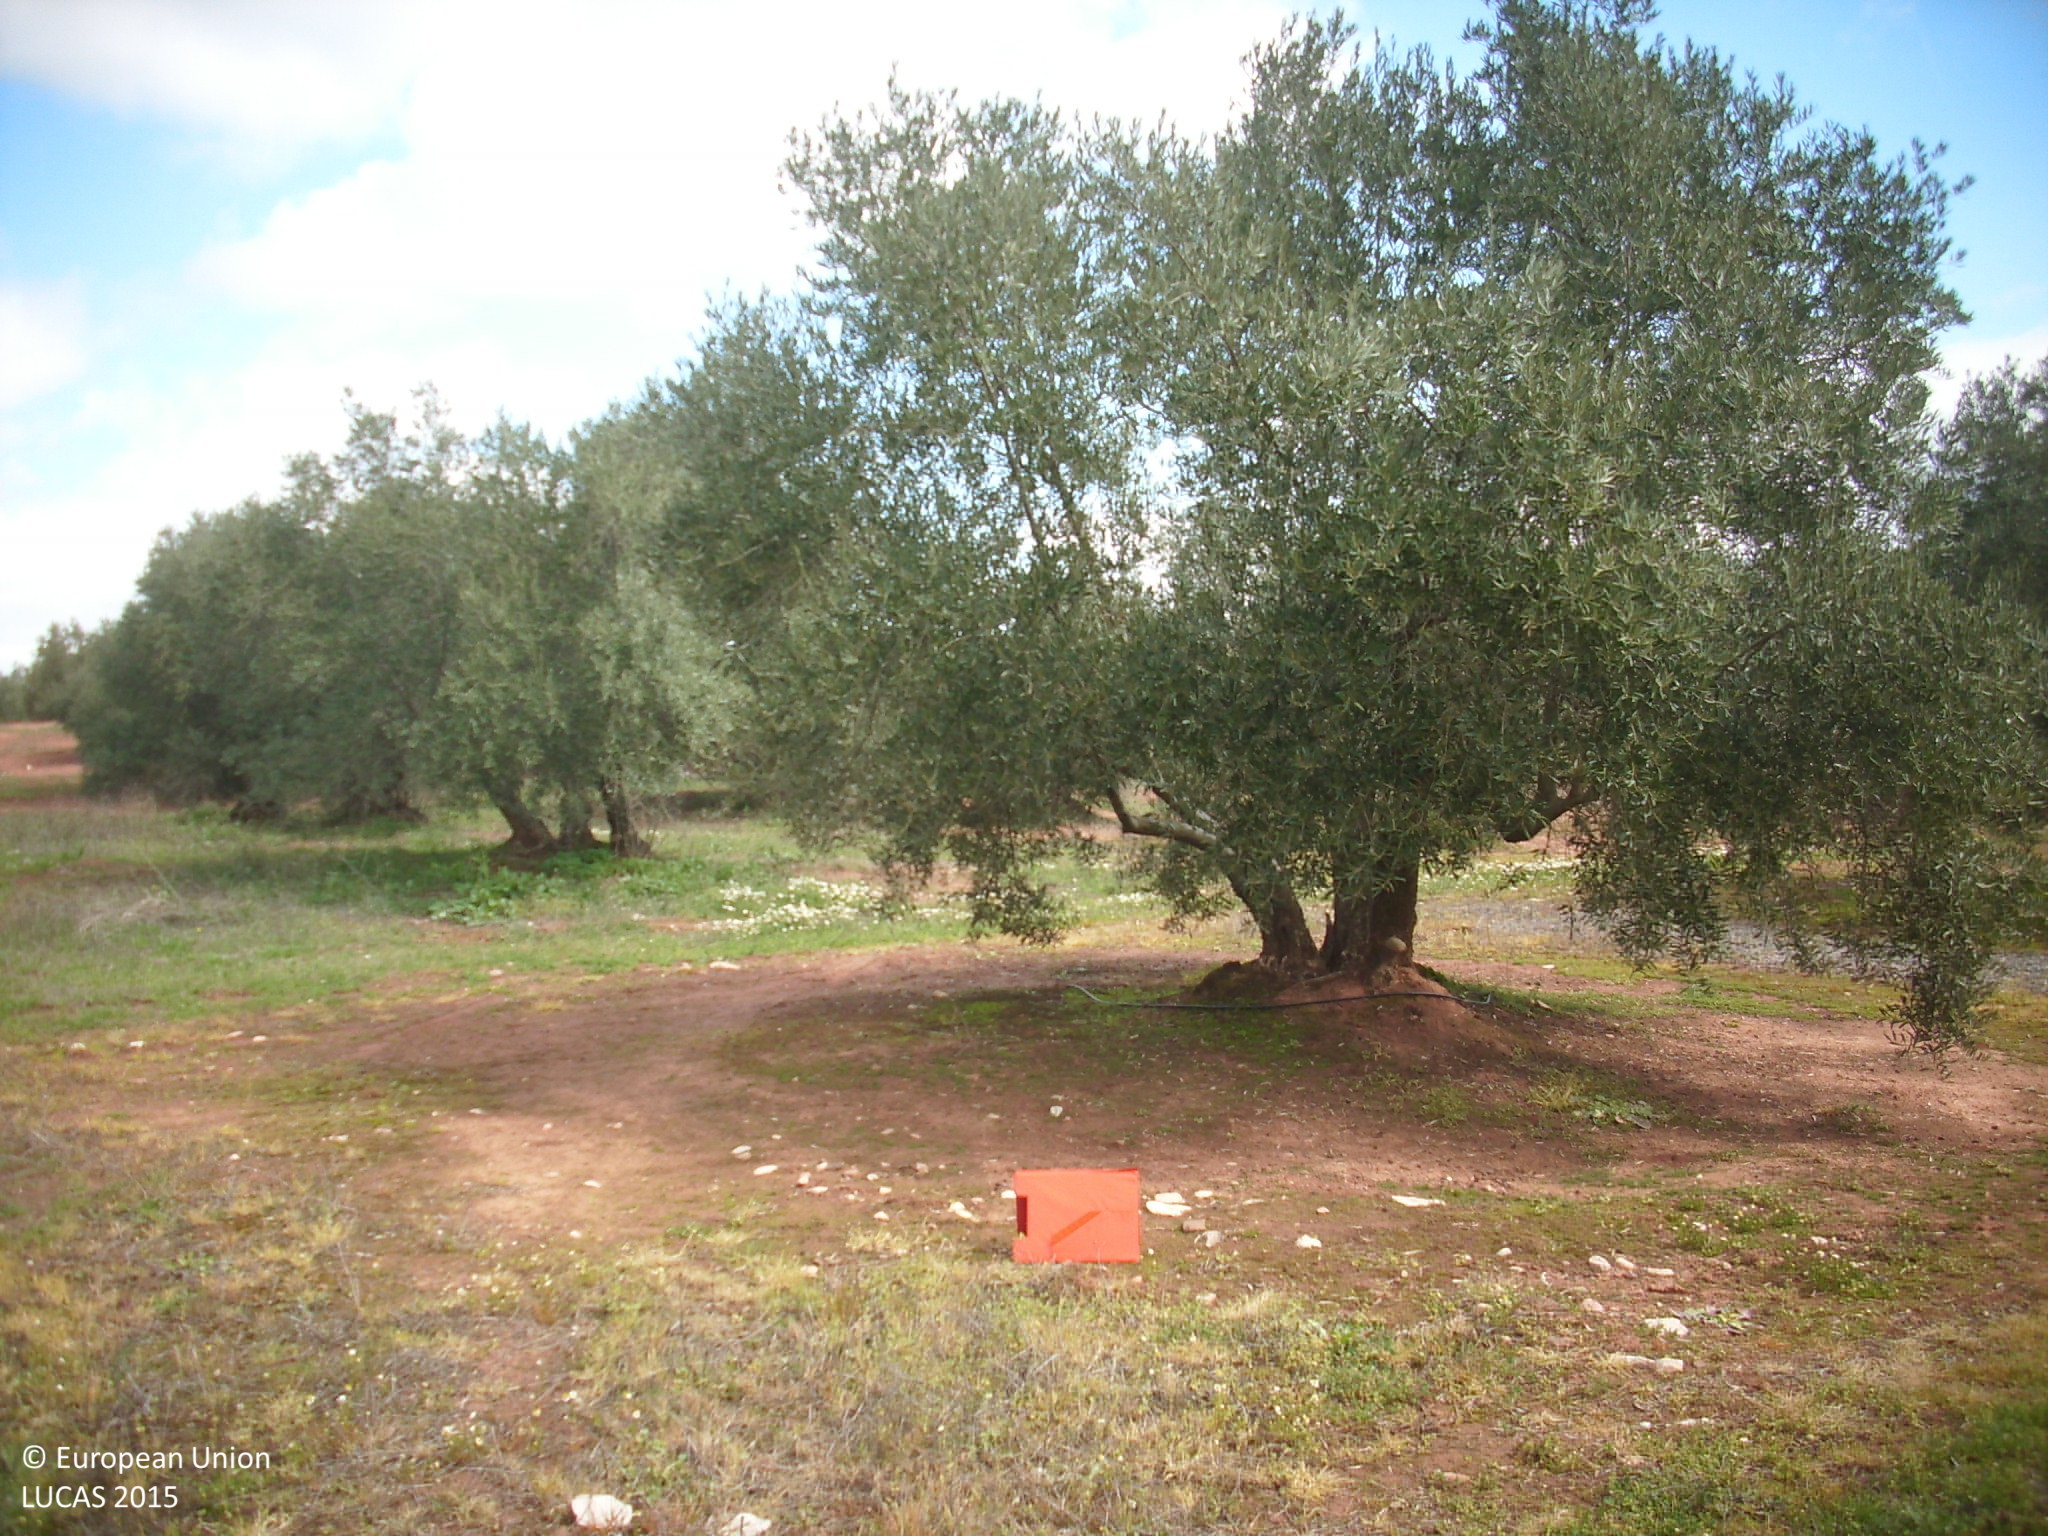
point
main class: Cropland
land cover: Olive groves
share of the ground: 25 - 50 %
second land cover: Spontaneously vegetated surfaces
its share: > 75 %
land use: Agriculture (excluding fallow land and kitchen gardens)
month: March
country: ES
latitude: 38.3343
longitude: -3.1473
